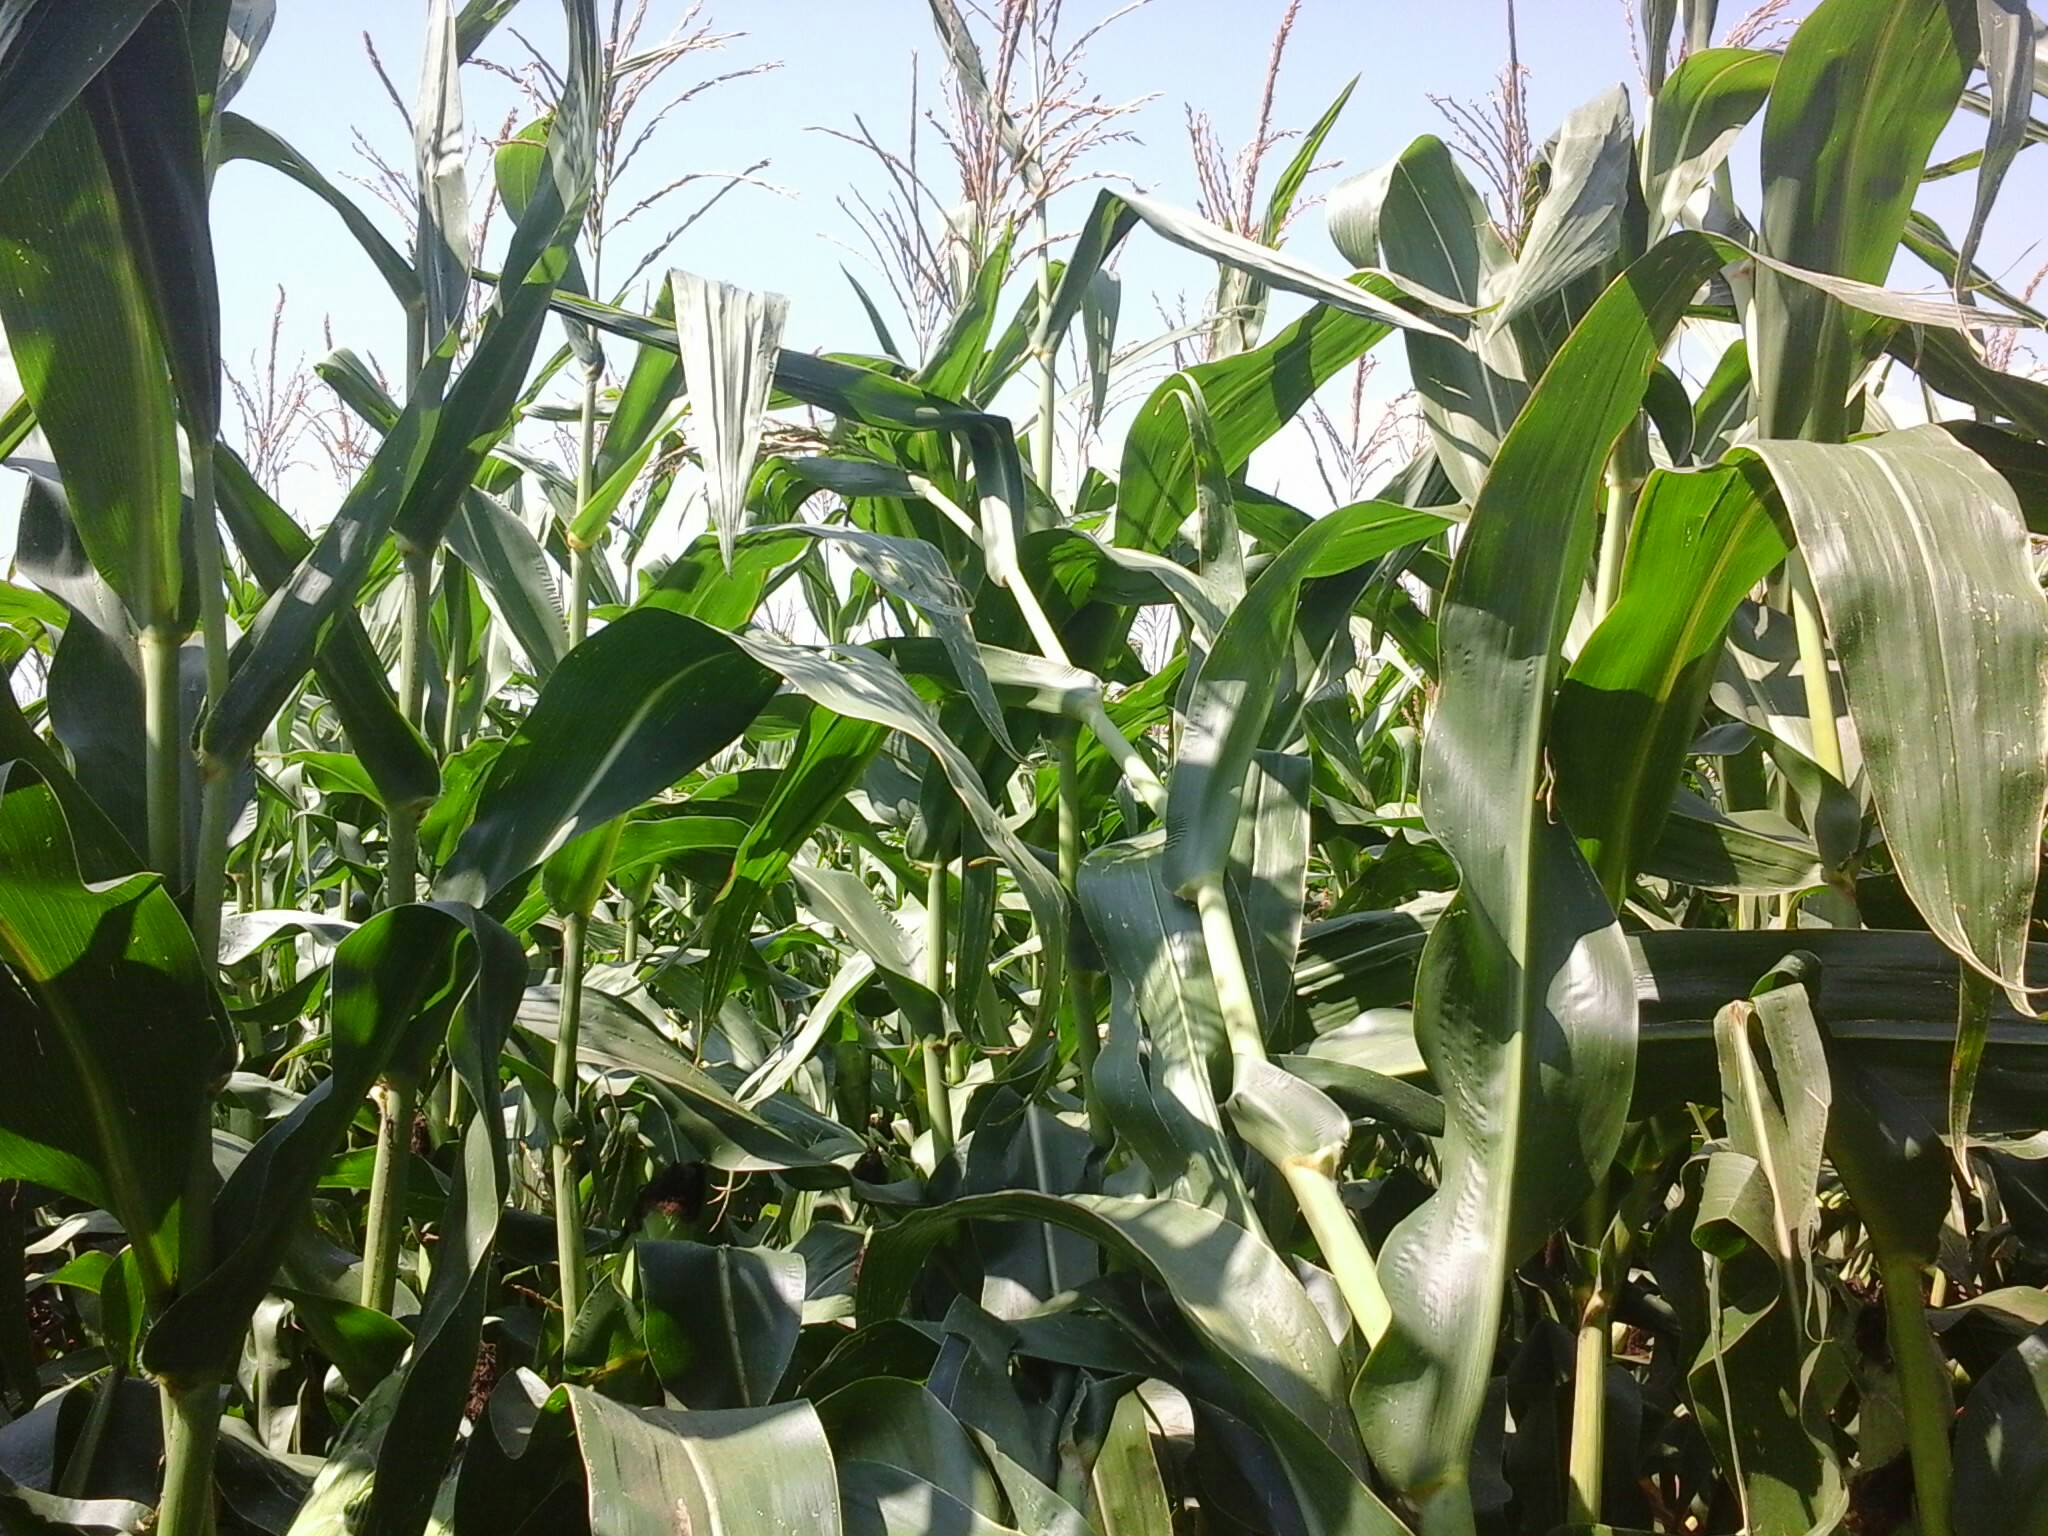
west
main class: Cropland
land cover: Maize
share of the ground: > 75 %
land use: Agriculture (excluding fallow land and kitchen gardens)
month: August
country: HU
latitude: 47.3857
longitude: 18.5312
